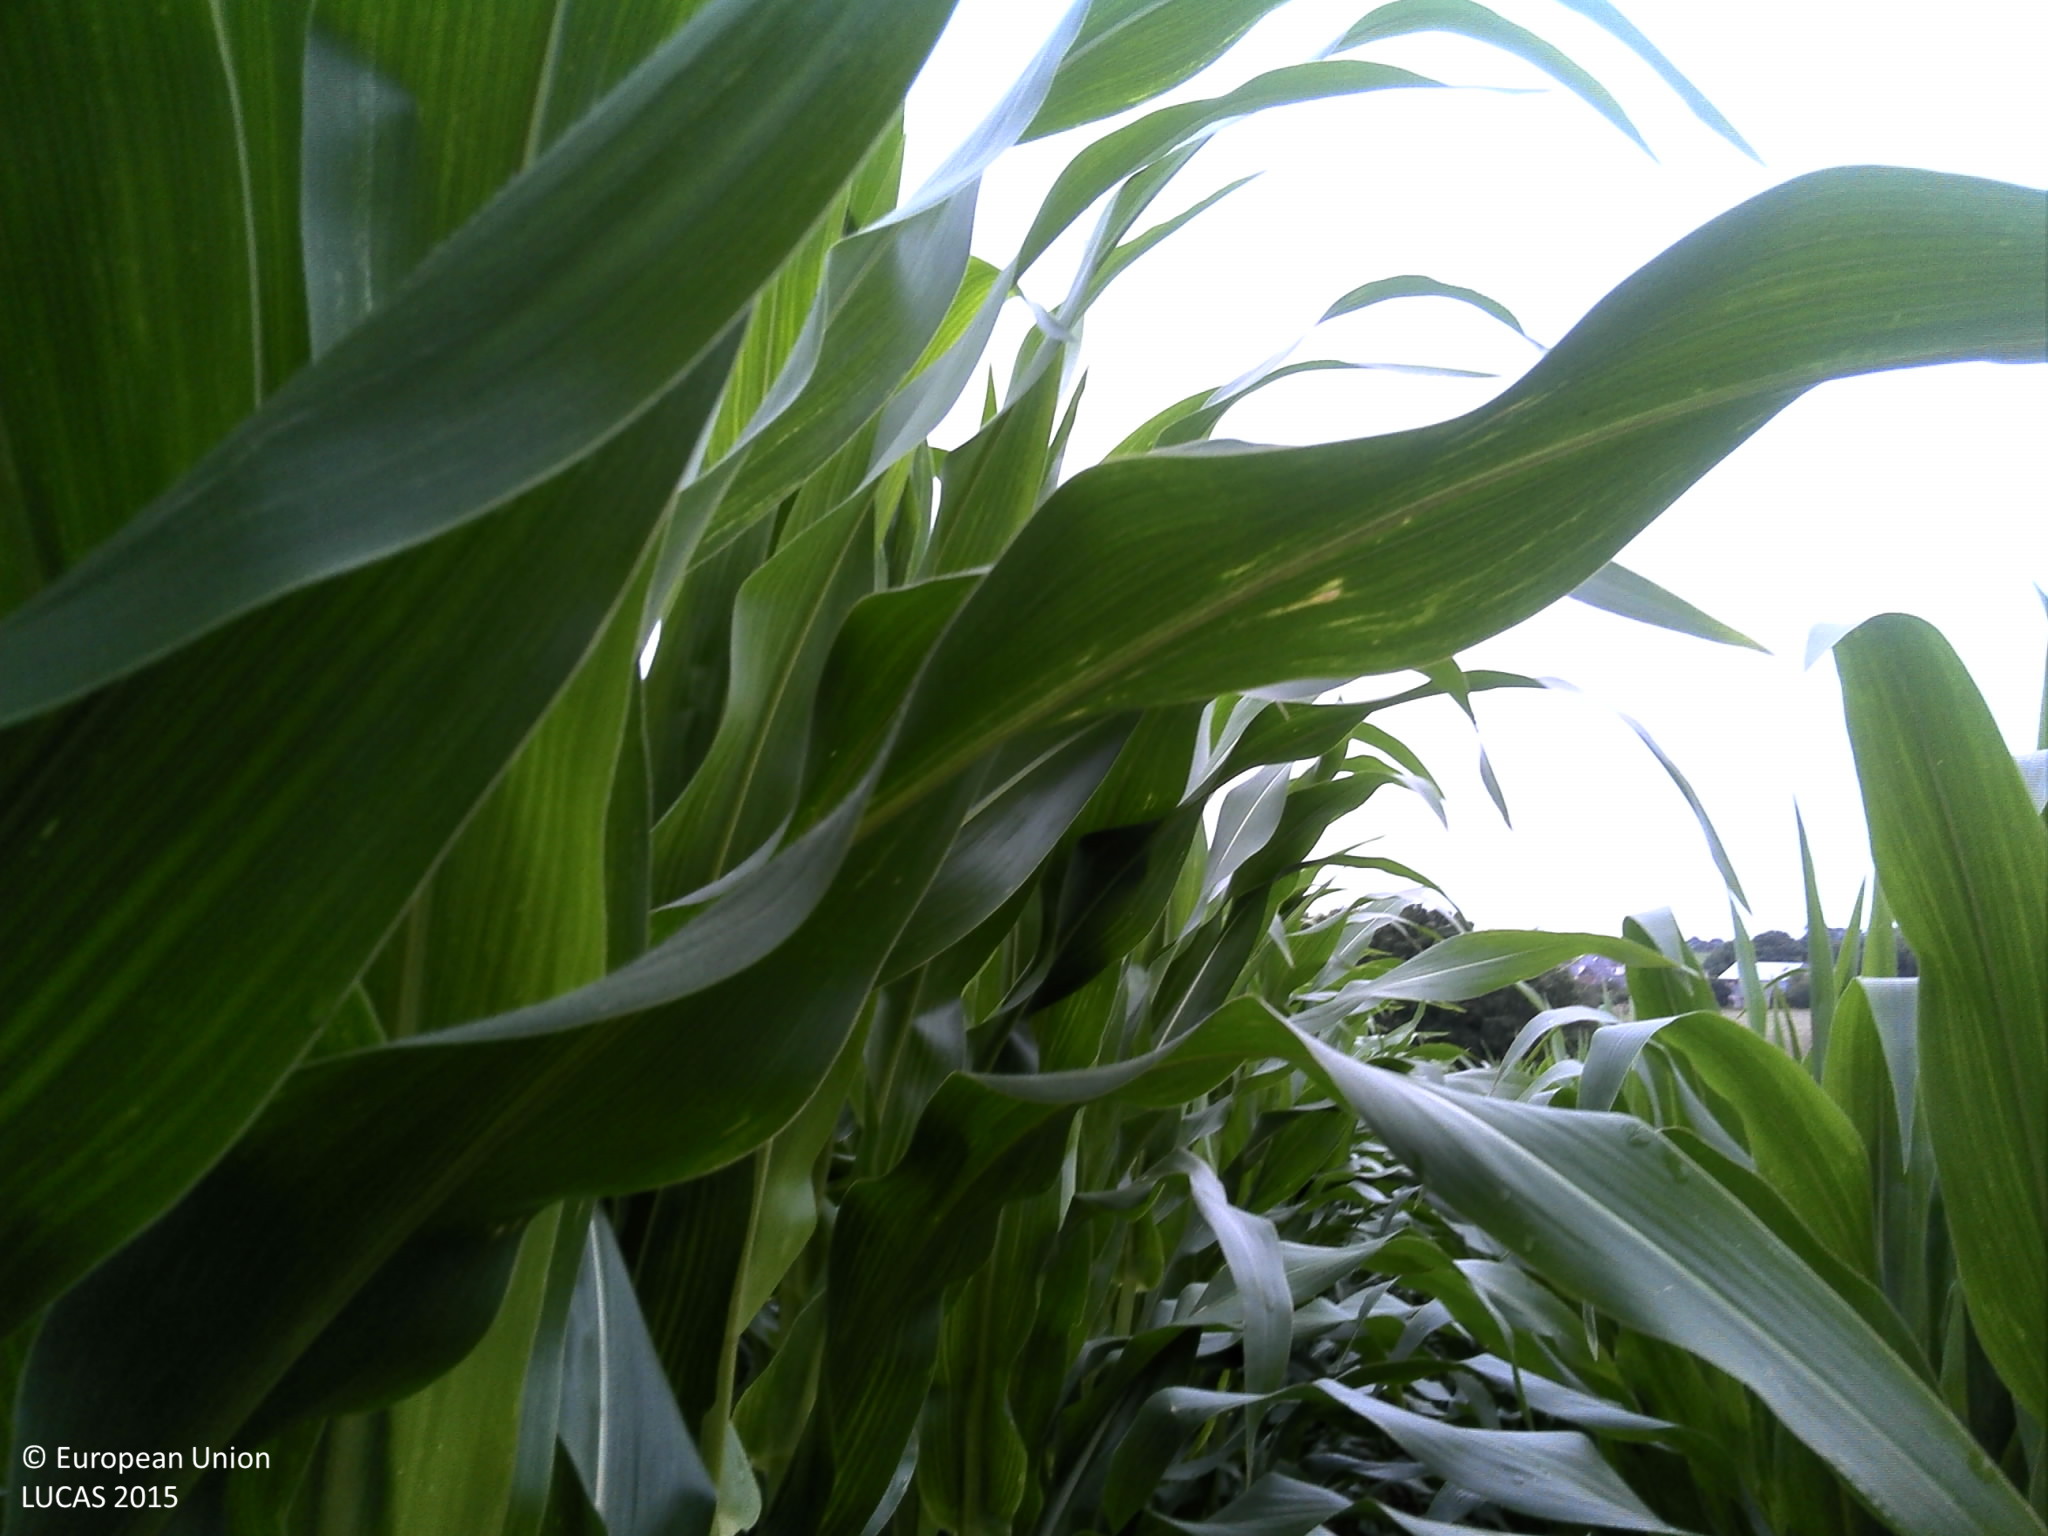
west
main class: Cropland
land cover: Maize
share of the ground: > 75 %
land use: Agriculture (excluding fallow land and kitchen gardens)
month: July
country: FR
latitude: 48.4500
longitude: -4.1942
